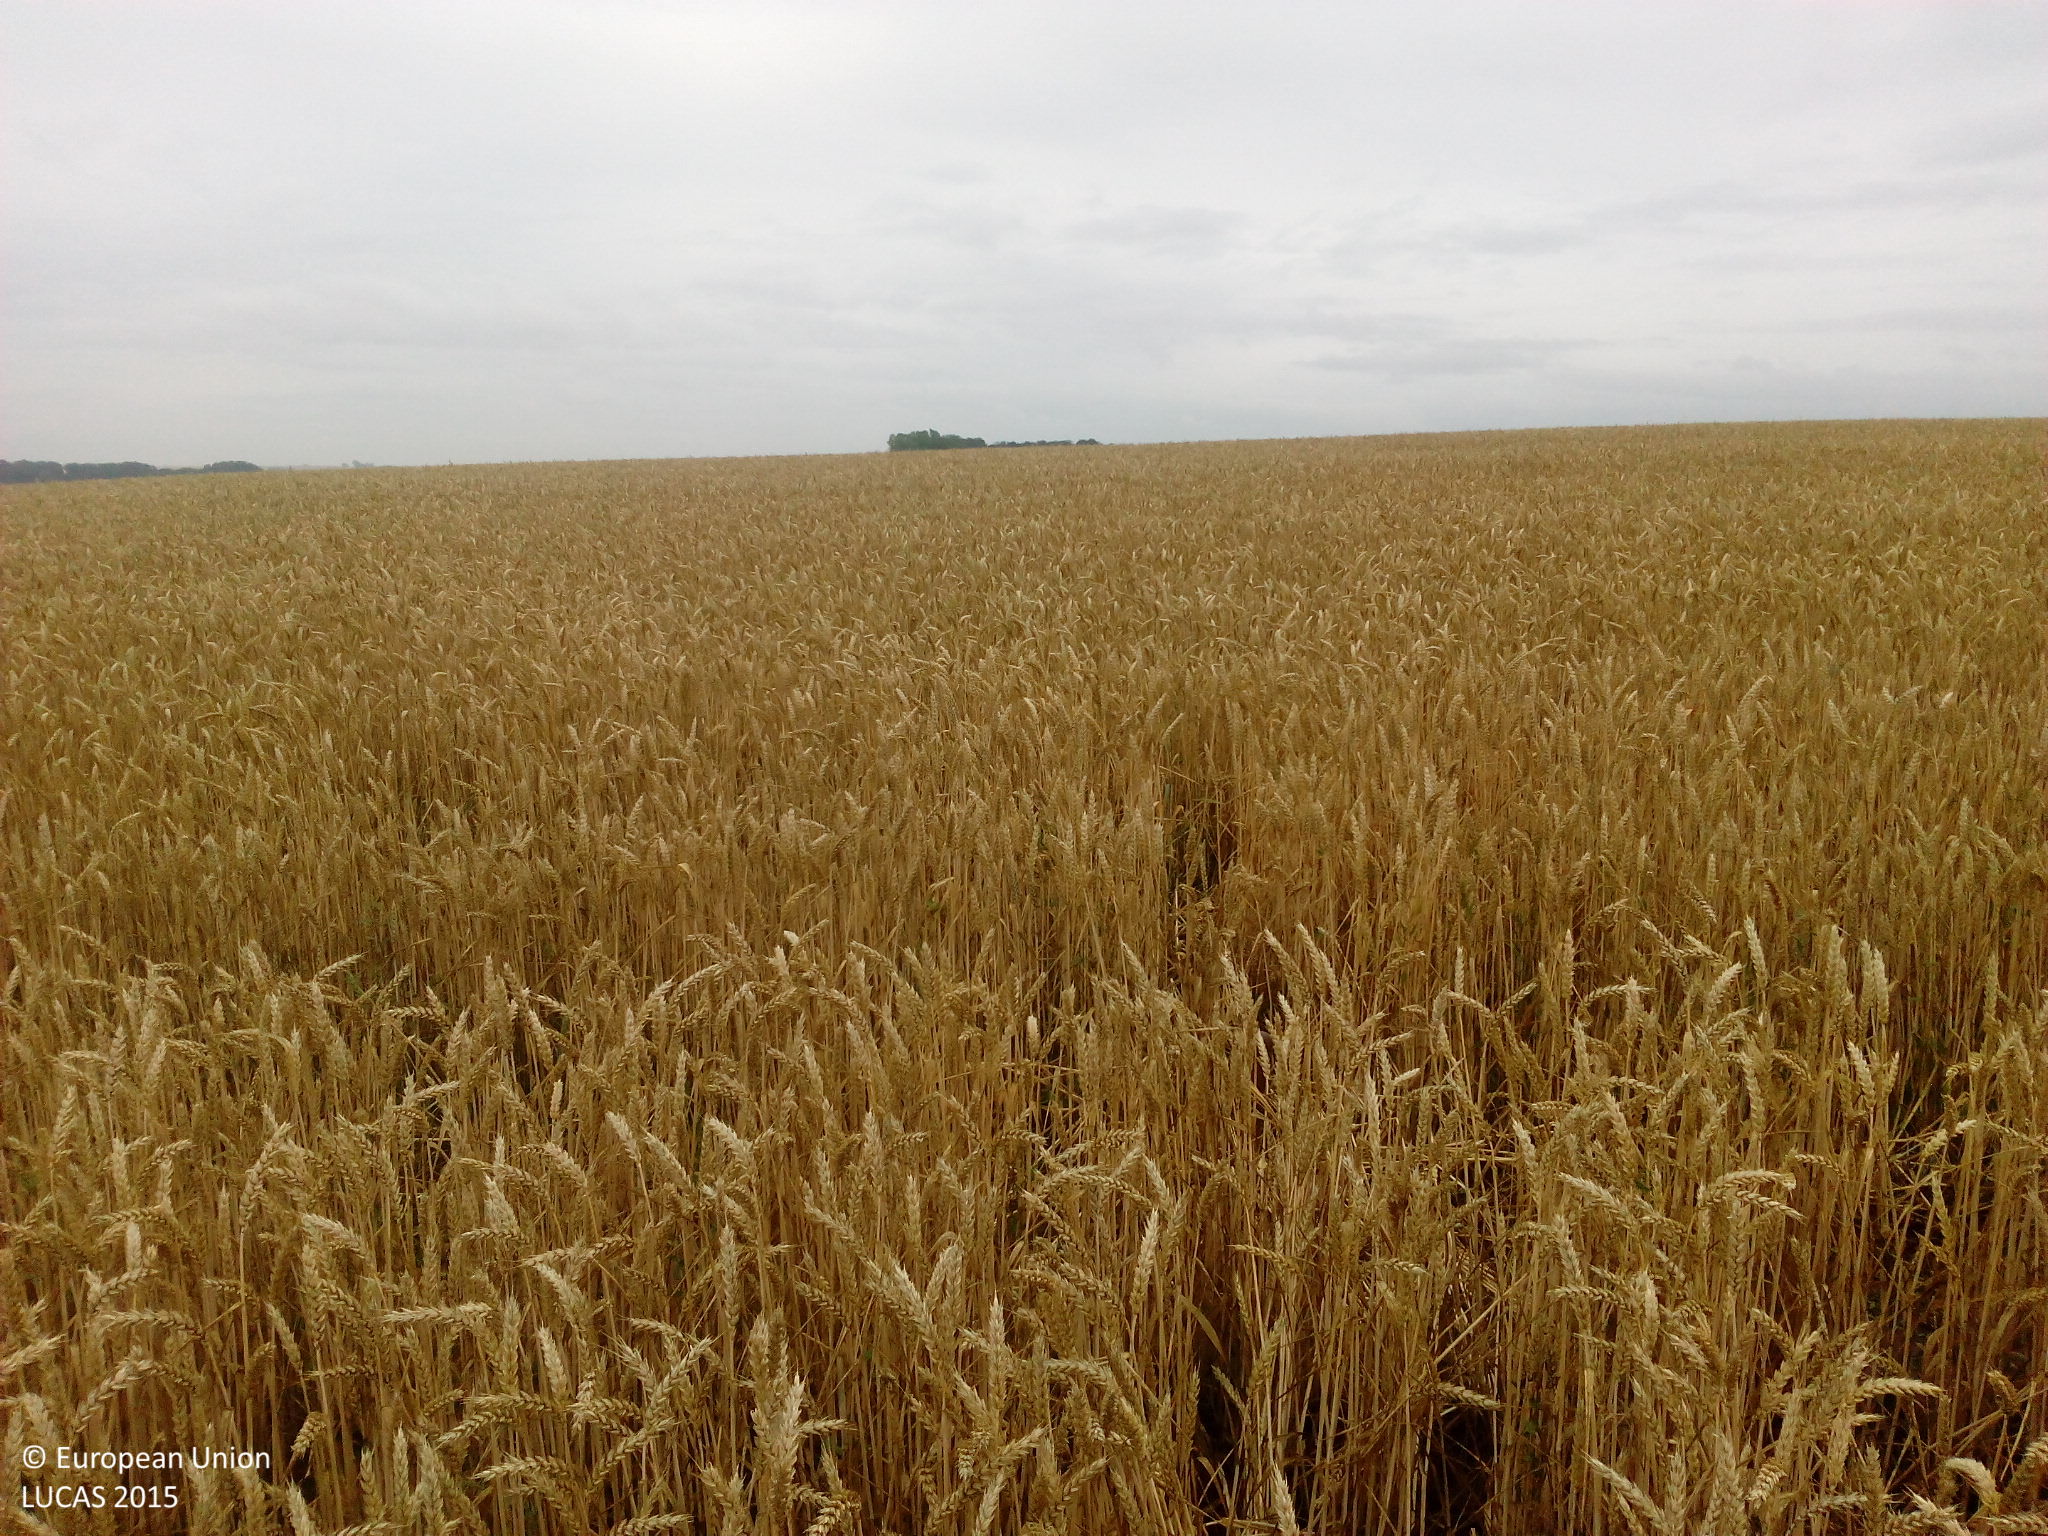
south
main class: Cropland
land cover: Common wheat
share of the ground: > 75 %
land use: Agriculture (excluding fallow land and kitchen gardens)
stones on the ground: < 10 %
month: July
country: DE
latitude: 51.8100
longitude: 11.5516
